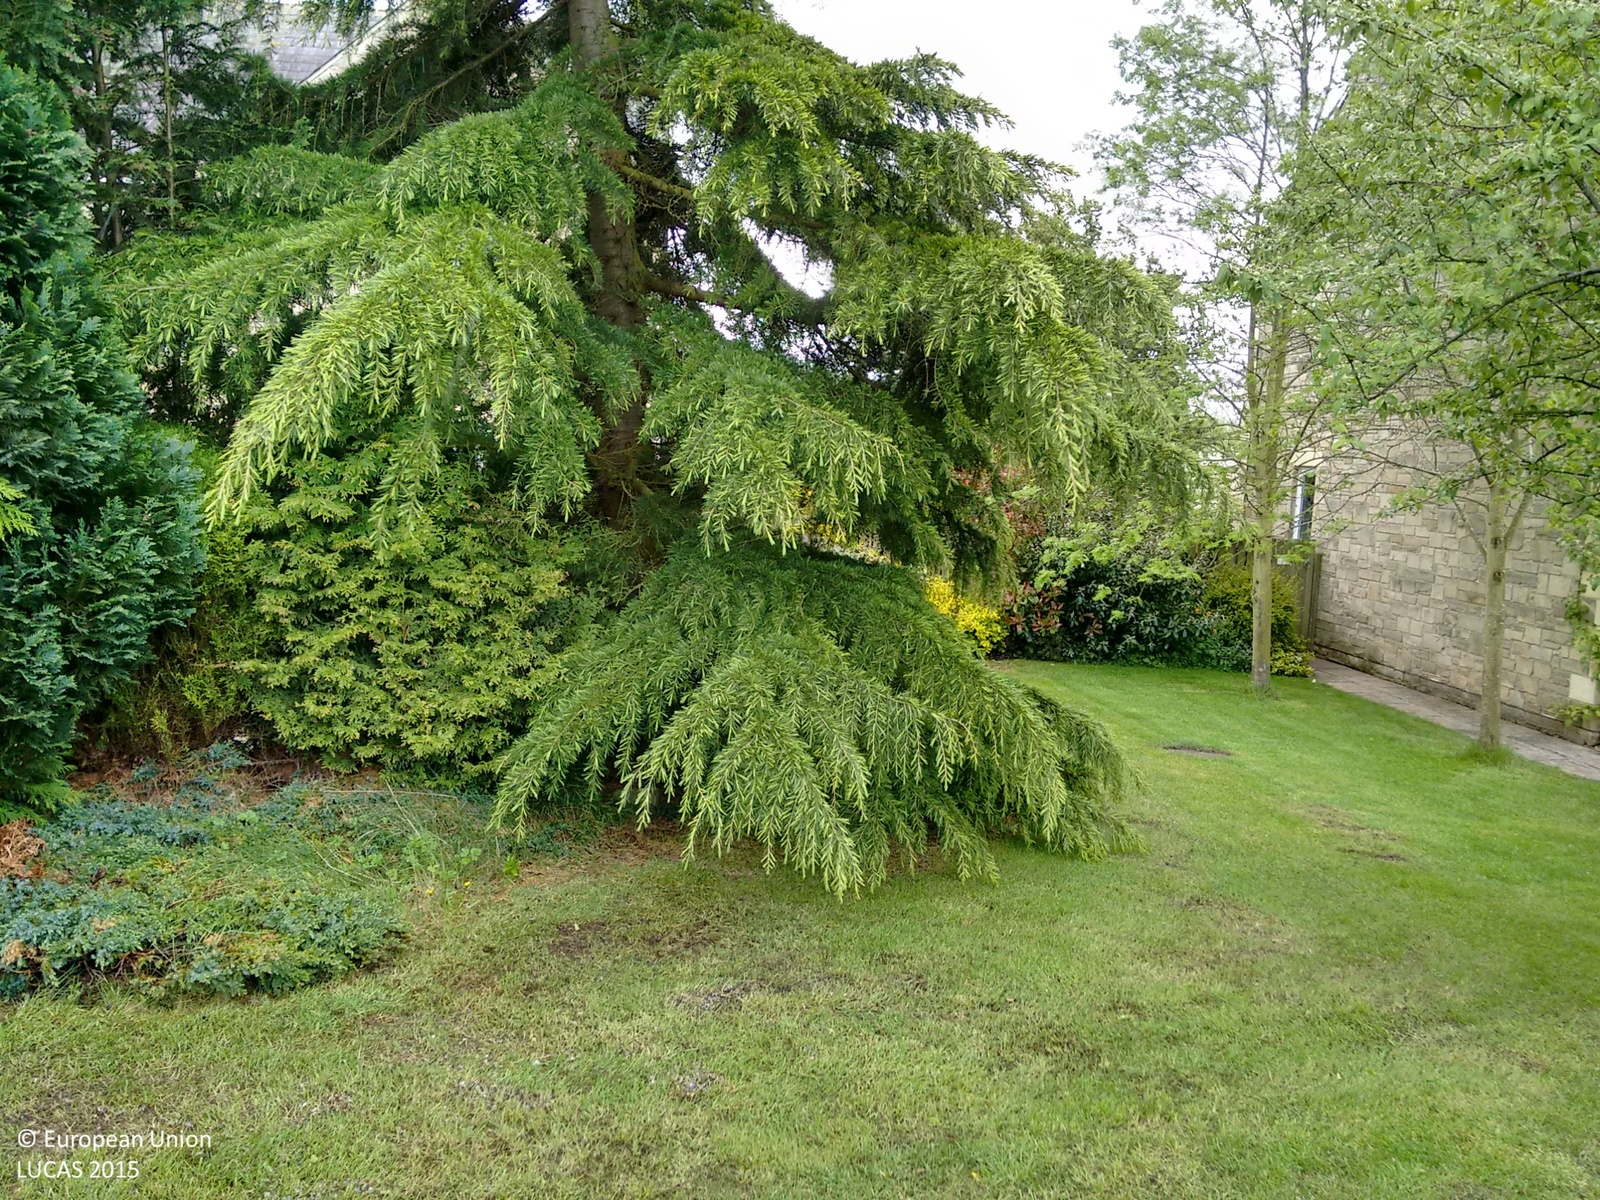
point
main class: Woodland
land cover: Spruce dominated mixed woodland
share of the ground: 50 - 75 %
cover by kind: coniferous forest trees 25 %, broadleaved forest trees 25 %, herbaceous plants 10 %
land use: Residential
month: May
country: GB
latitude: 55.0048
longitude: -2.1743
